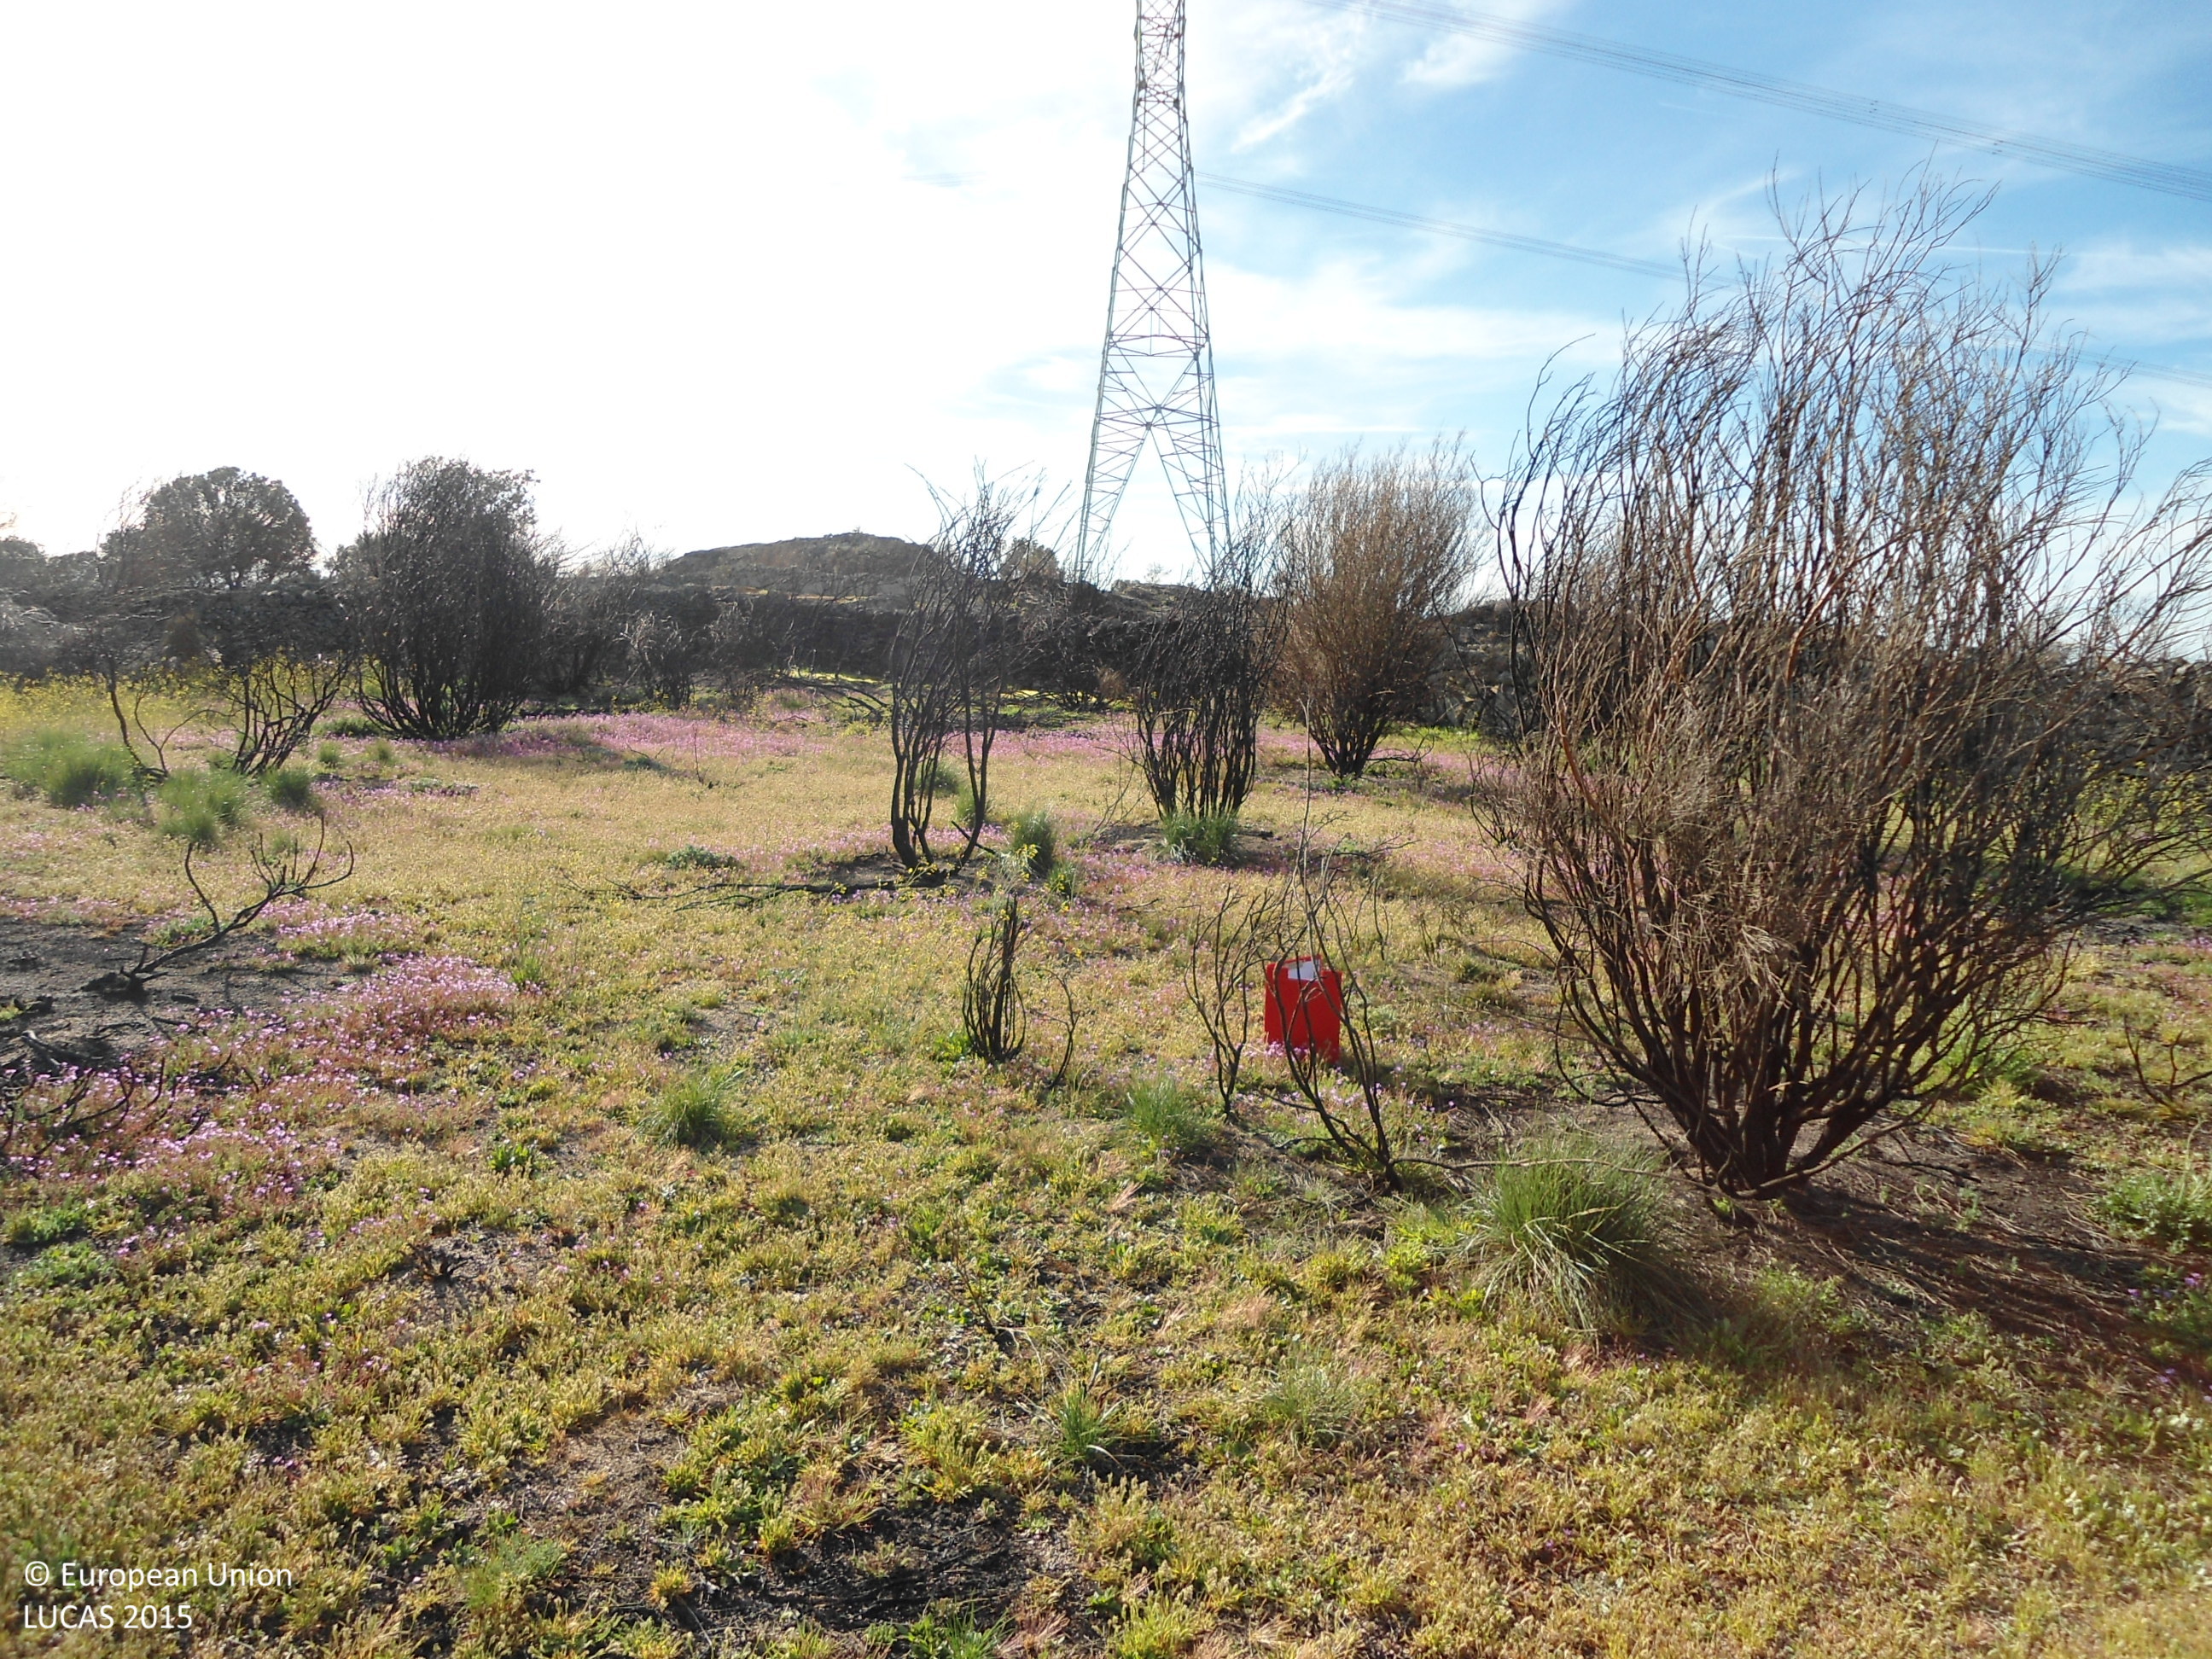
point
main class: Grassland
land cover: Grassland without tree/shrub cover
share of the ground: > 75 %
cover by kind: herbaceous plants 100 %
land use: Agriculture (excluding fallow land and kitchen gardens)
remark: Burnt area
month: April
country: ES
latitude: 41.5267
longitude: -6.0687
